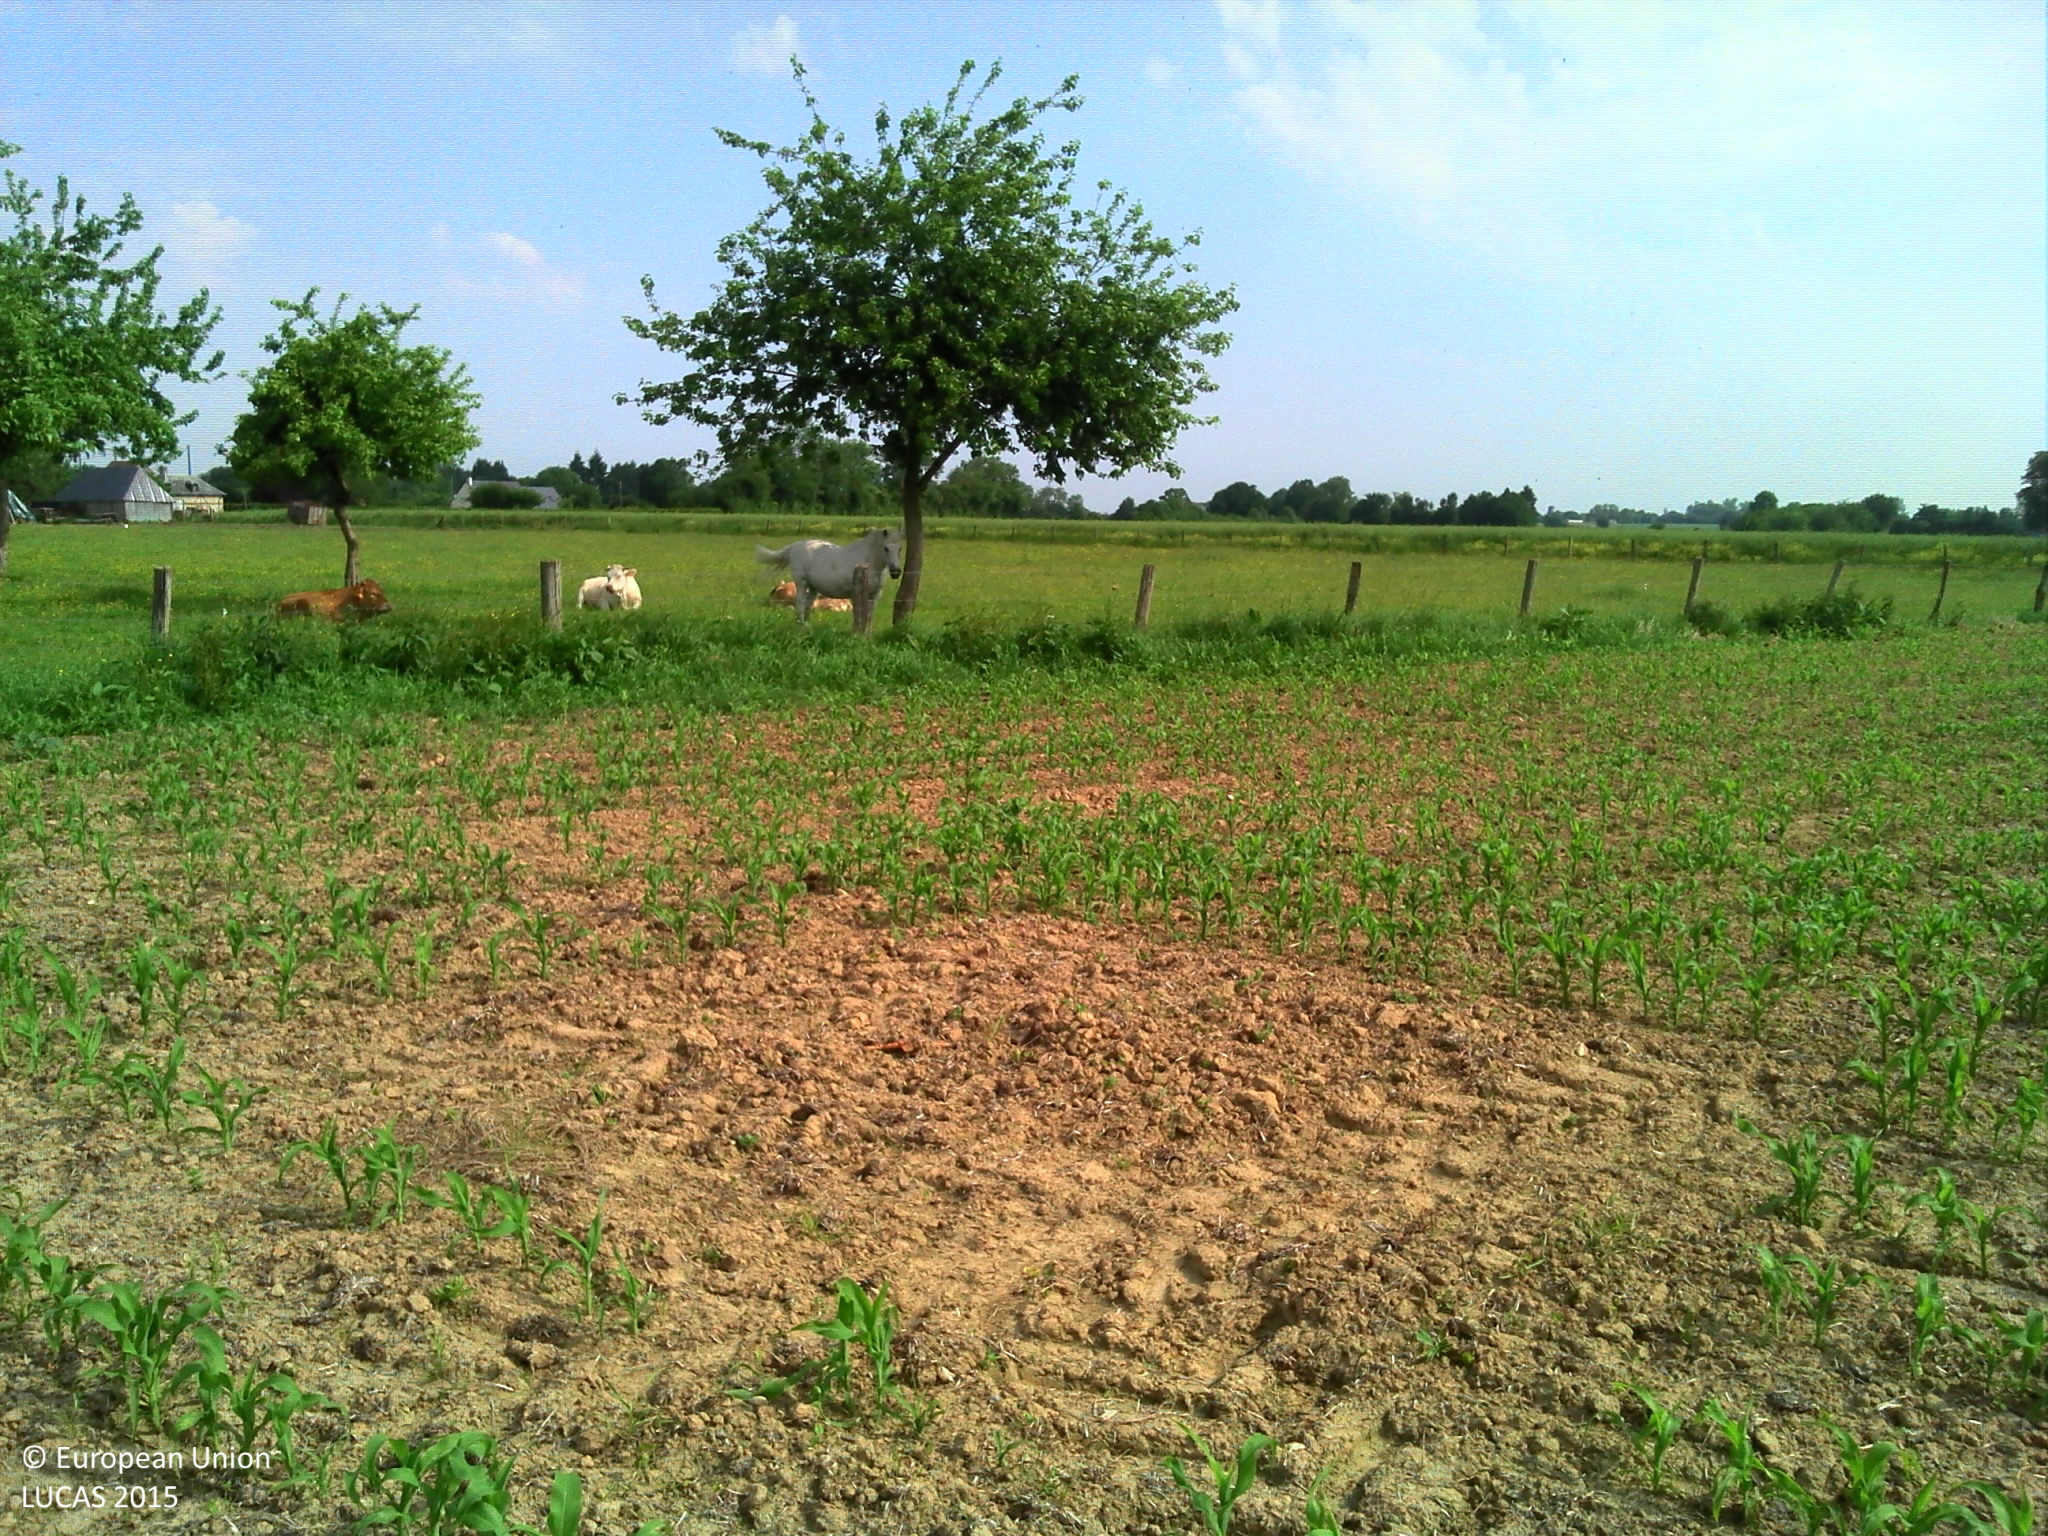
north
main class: Cropland
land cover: Maize
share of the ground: 10 - 25 %
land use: Agriculture (excluding fallow land and kitchen gardens)
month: June
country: FR
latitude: 49.2124
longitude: 0.3494
